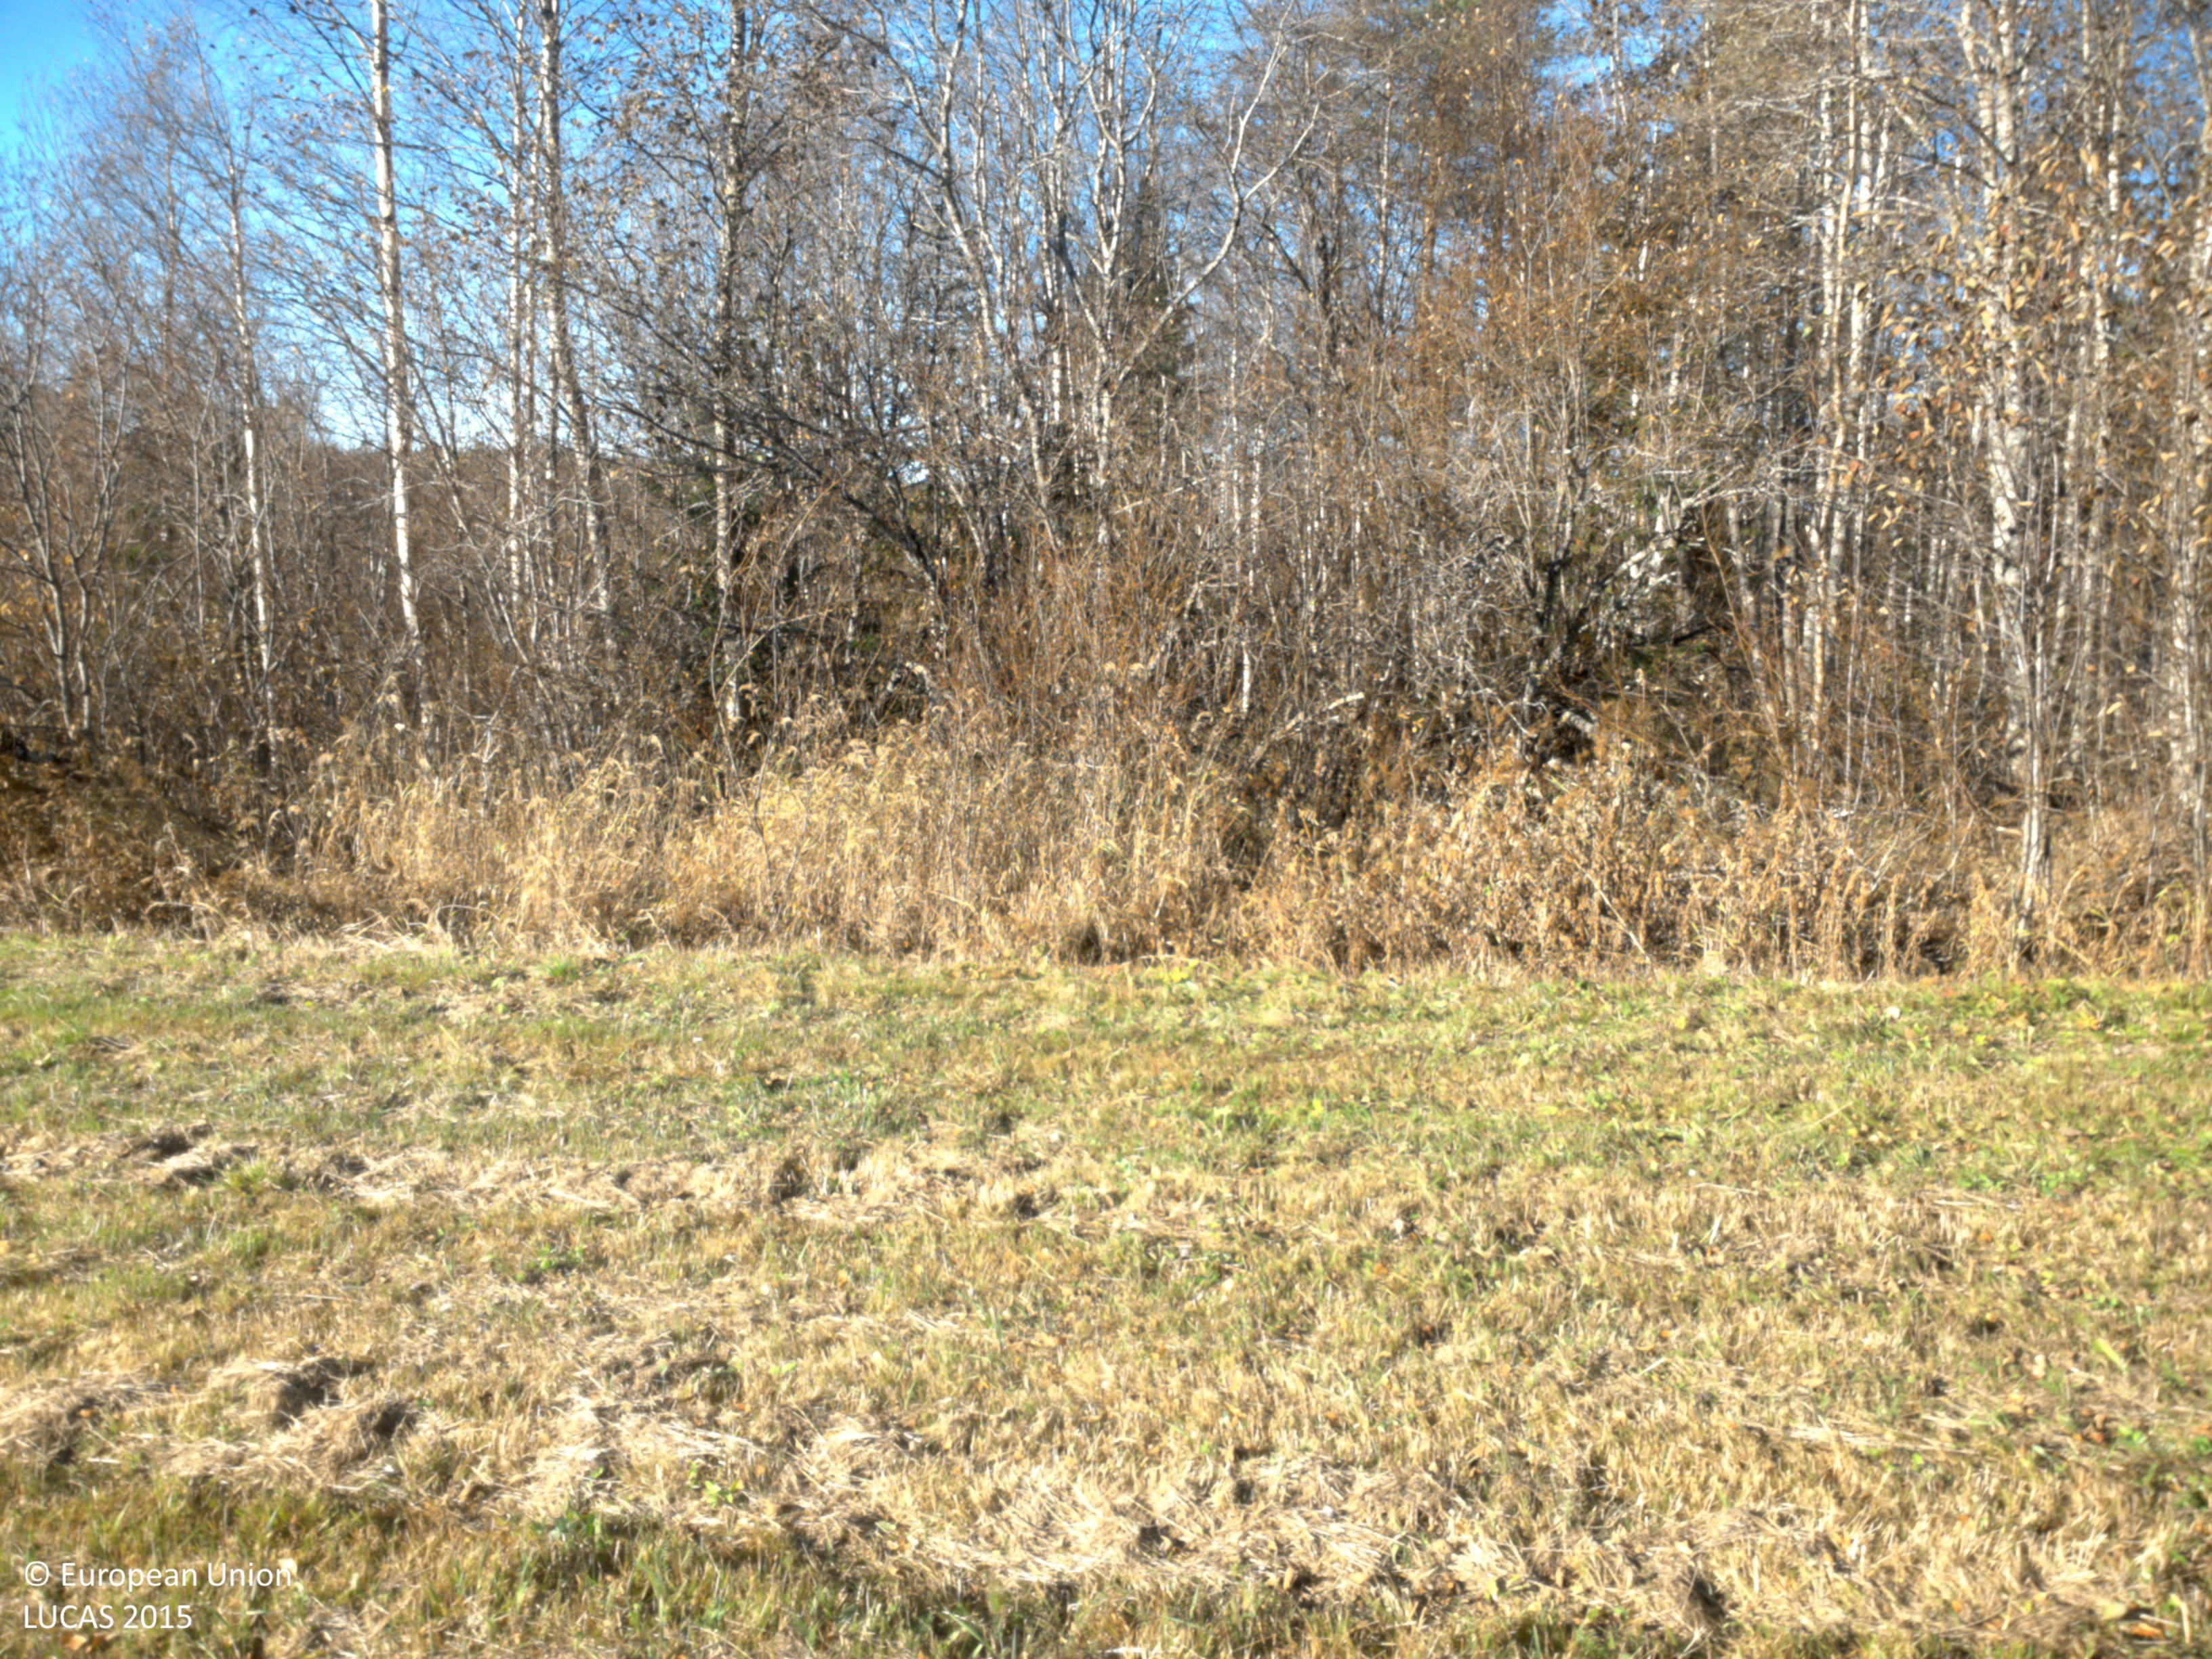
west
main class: Grassland
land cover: Grassland without tree/shrub cover
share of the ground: > 75 %
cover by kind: herbaceous plants 95 %, lichens and mosses 5 %
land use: Agriculture (excluding fallow land and kitchen gardens)
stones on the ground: < 10 %
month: October
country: SE
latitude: 64.0408
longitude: 19.7849
